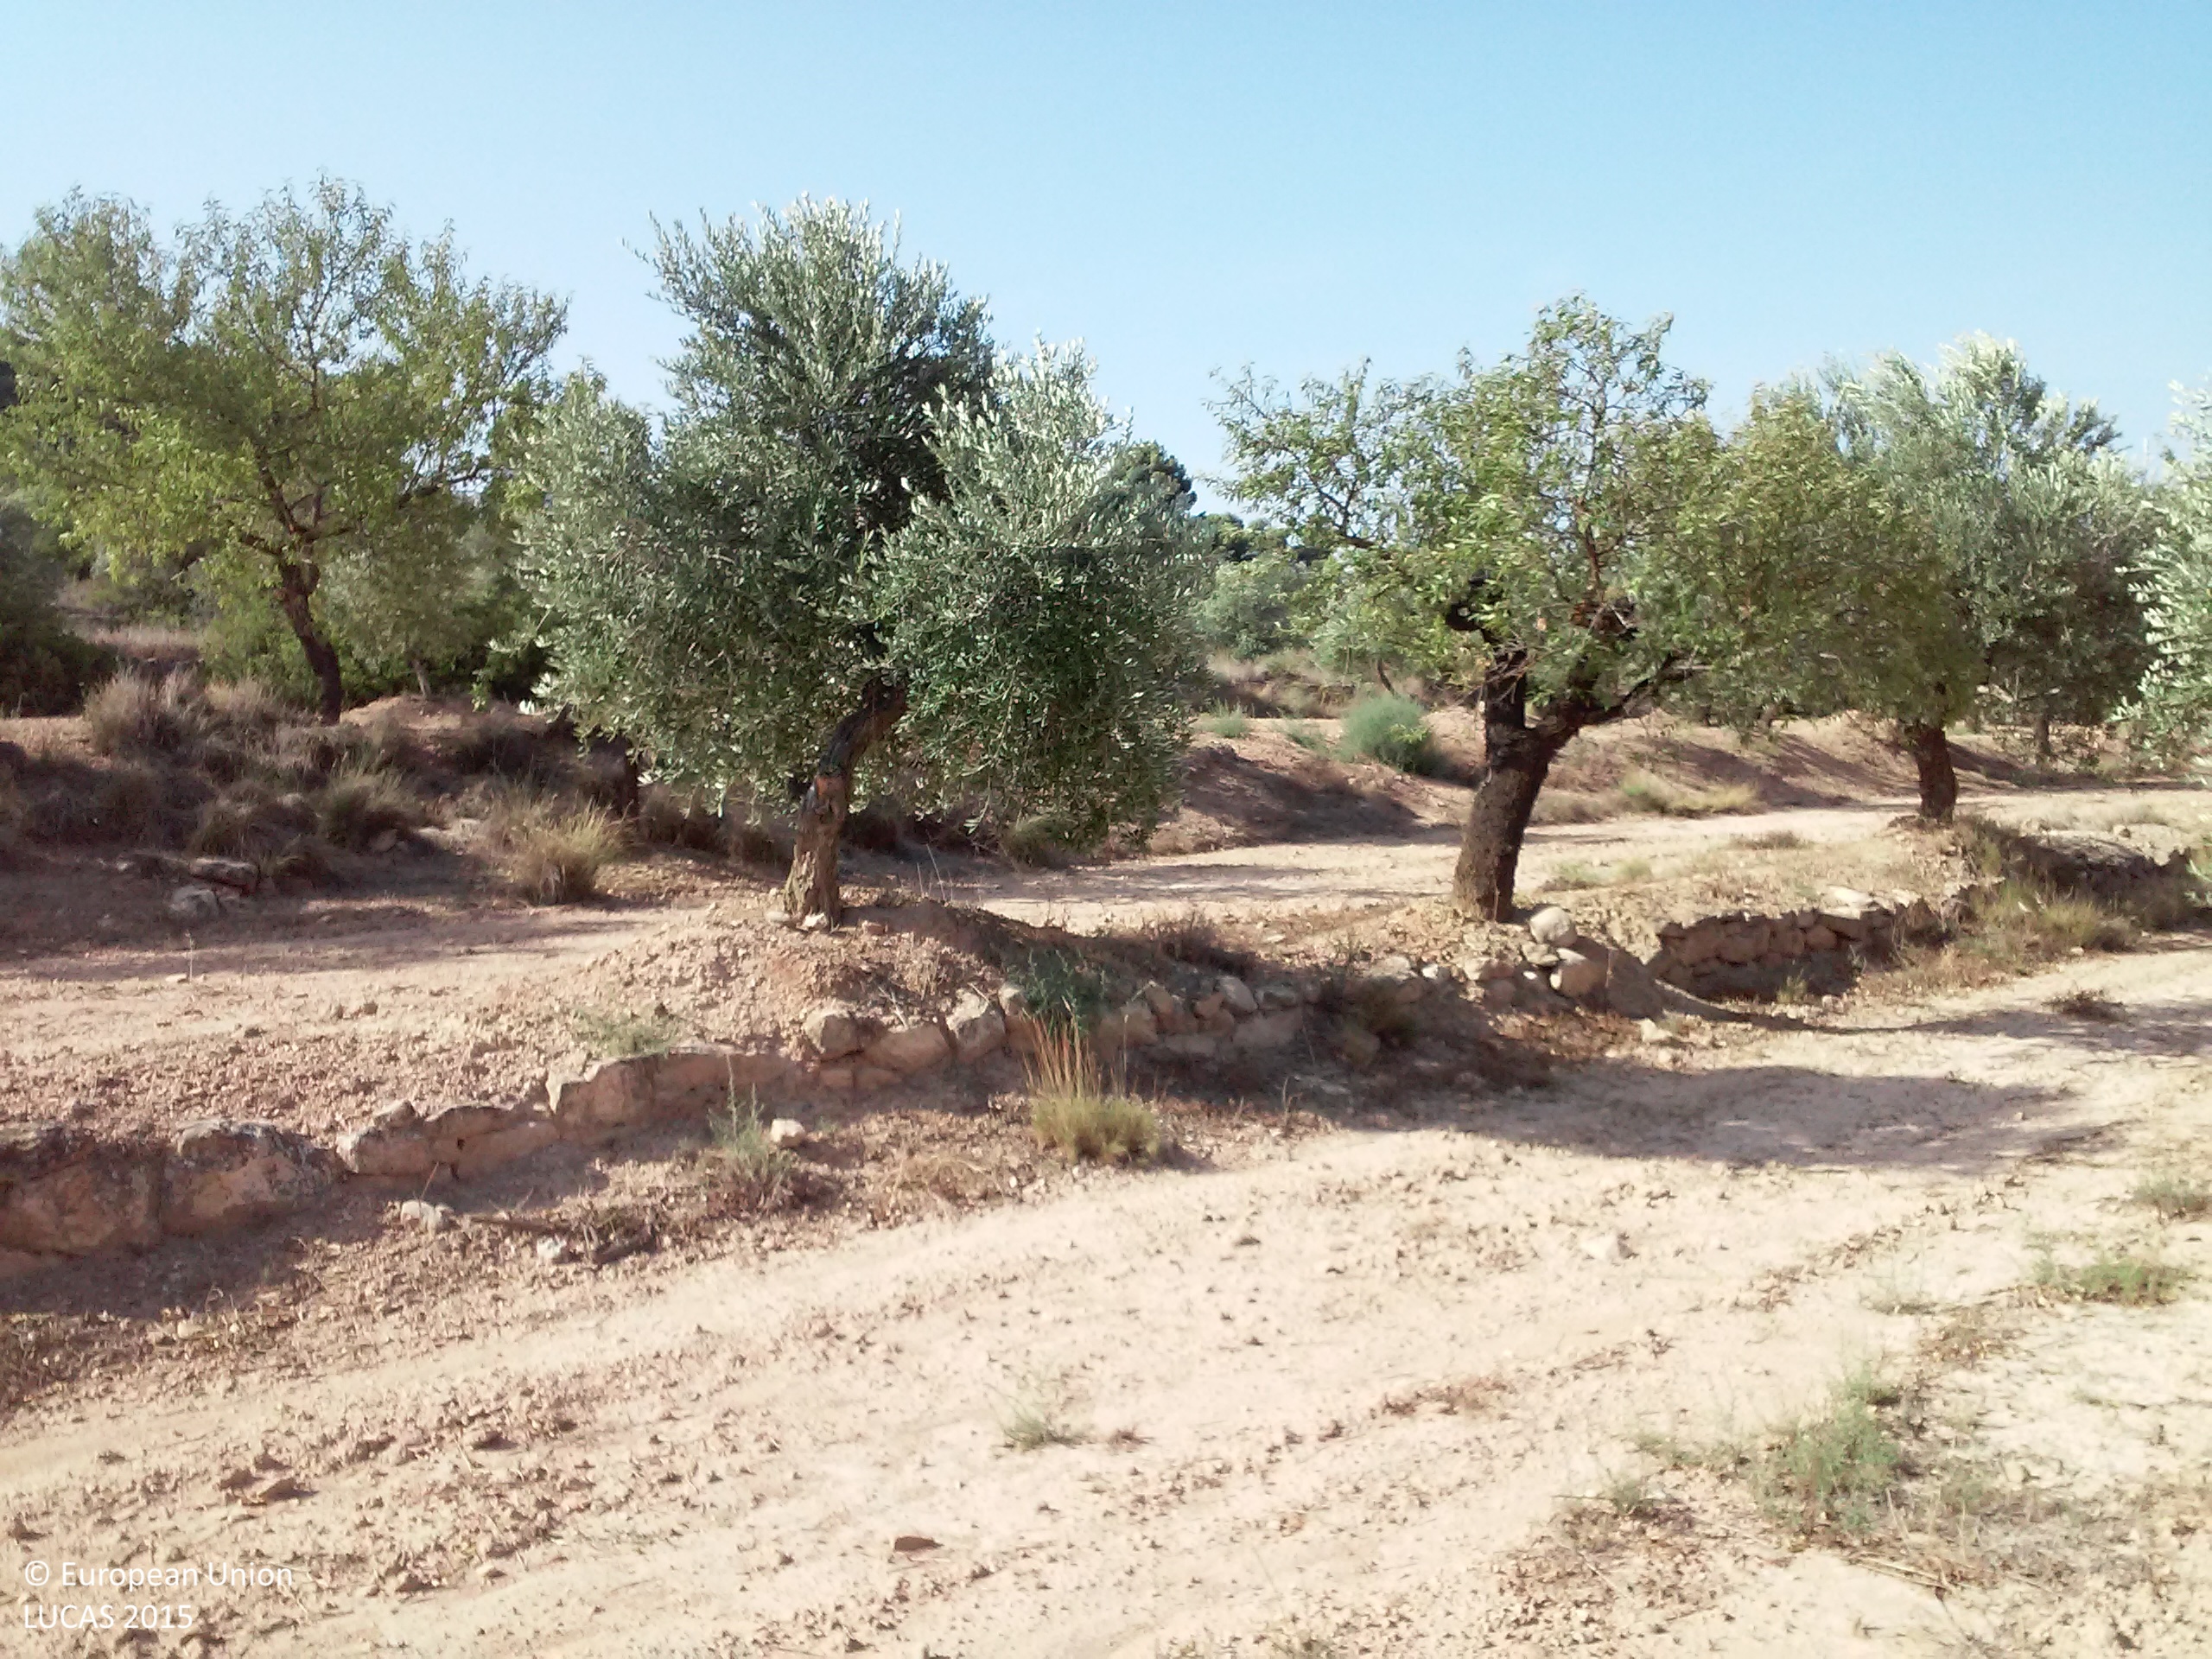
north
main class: Cropland
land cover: Olive groves
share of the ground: 10 - 25 %
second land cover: Nuts trees
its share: 10 - 25 %
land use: Agriculture (excluding fallow land and kitchen gardens)
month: August
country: ES
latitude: 41.3779
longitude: 0.5792
